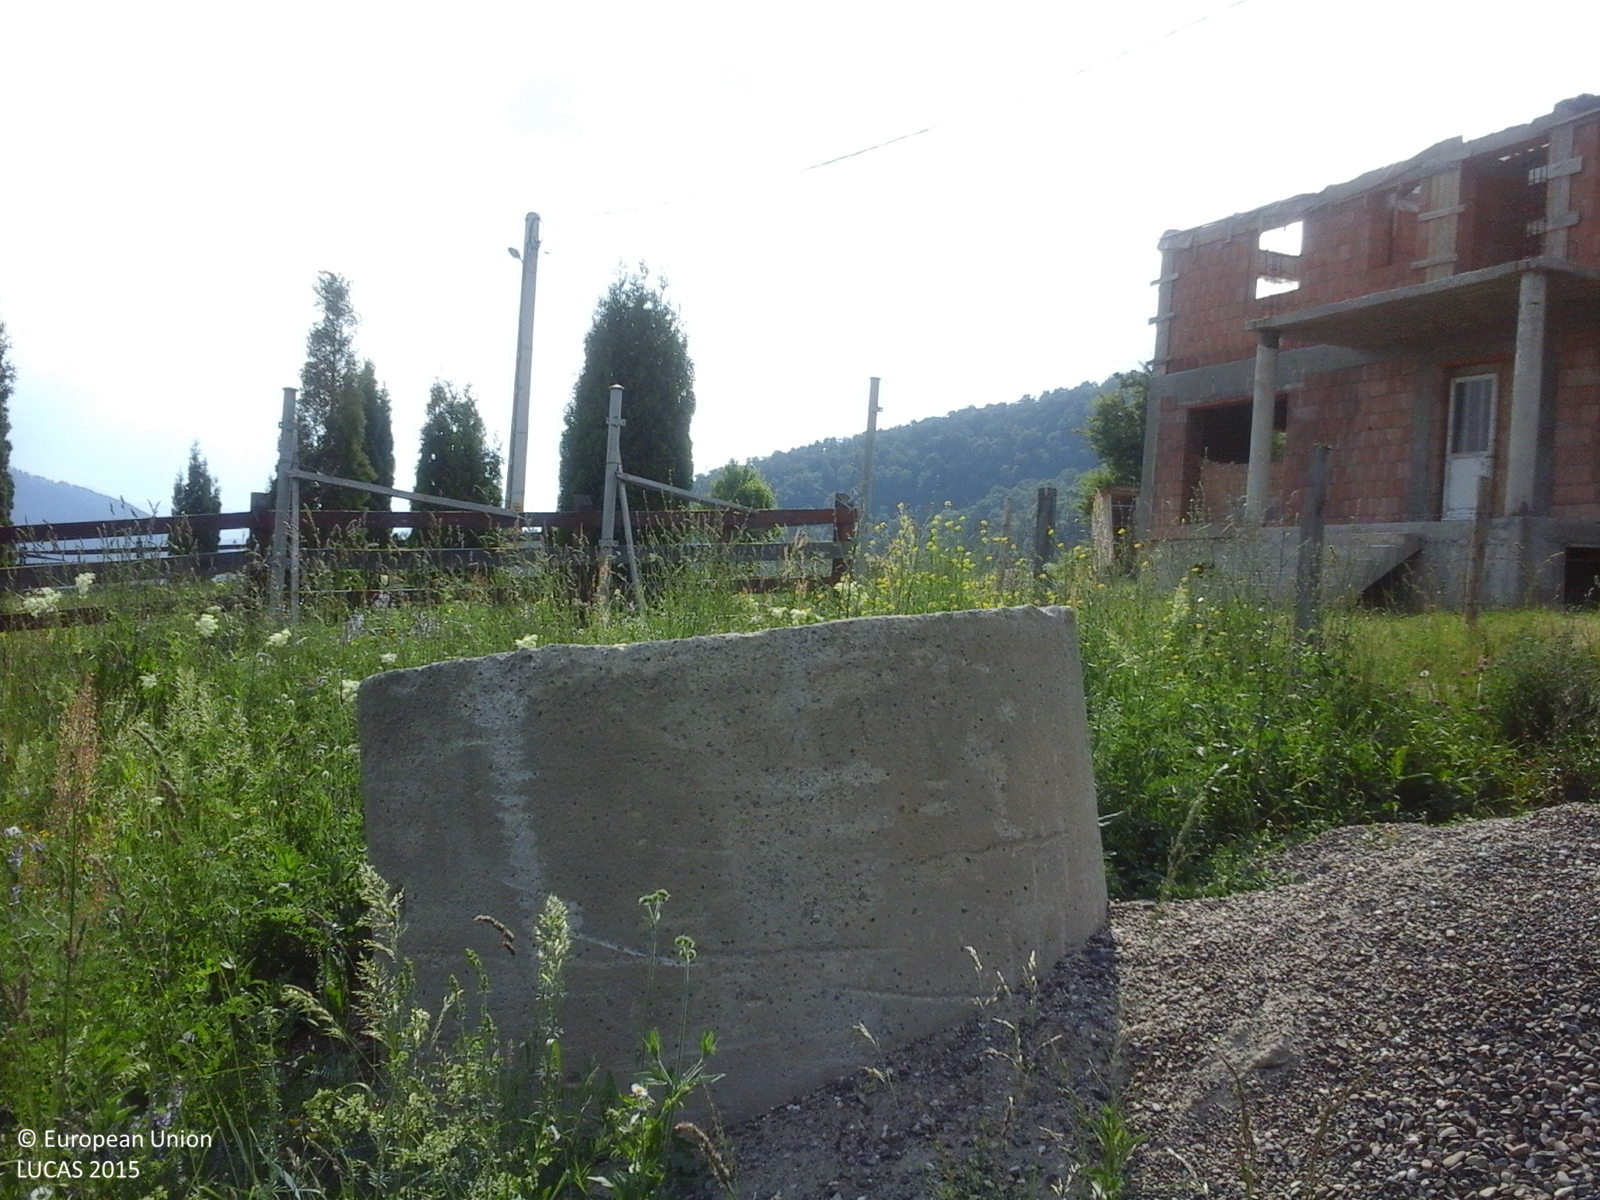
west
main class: Cropland
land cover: Other leguminous and mixtures for fodder
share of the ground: > 75 %
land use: Agriculture (excluding fallow land and kitchen gardens)
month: June
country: RO
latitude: 46.9477
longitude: 26.2788
